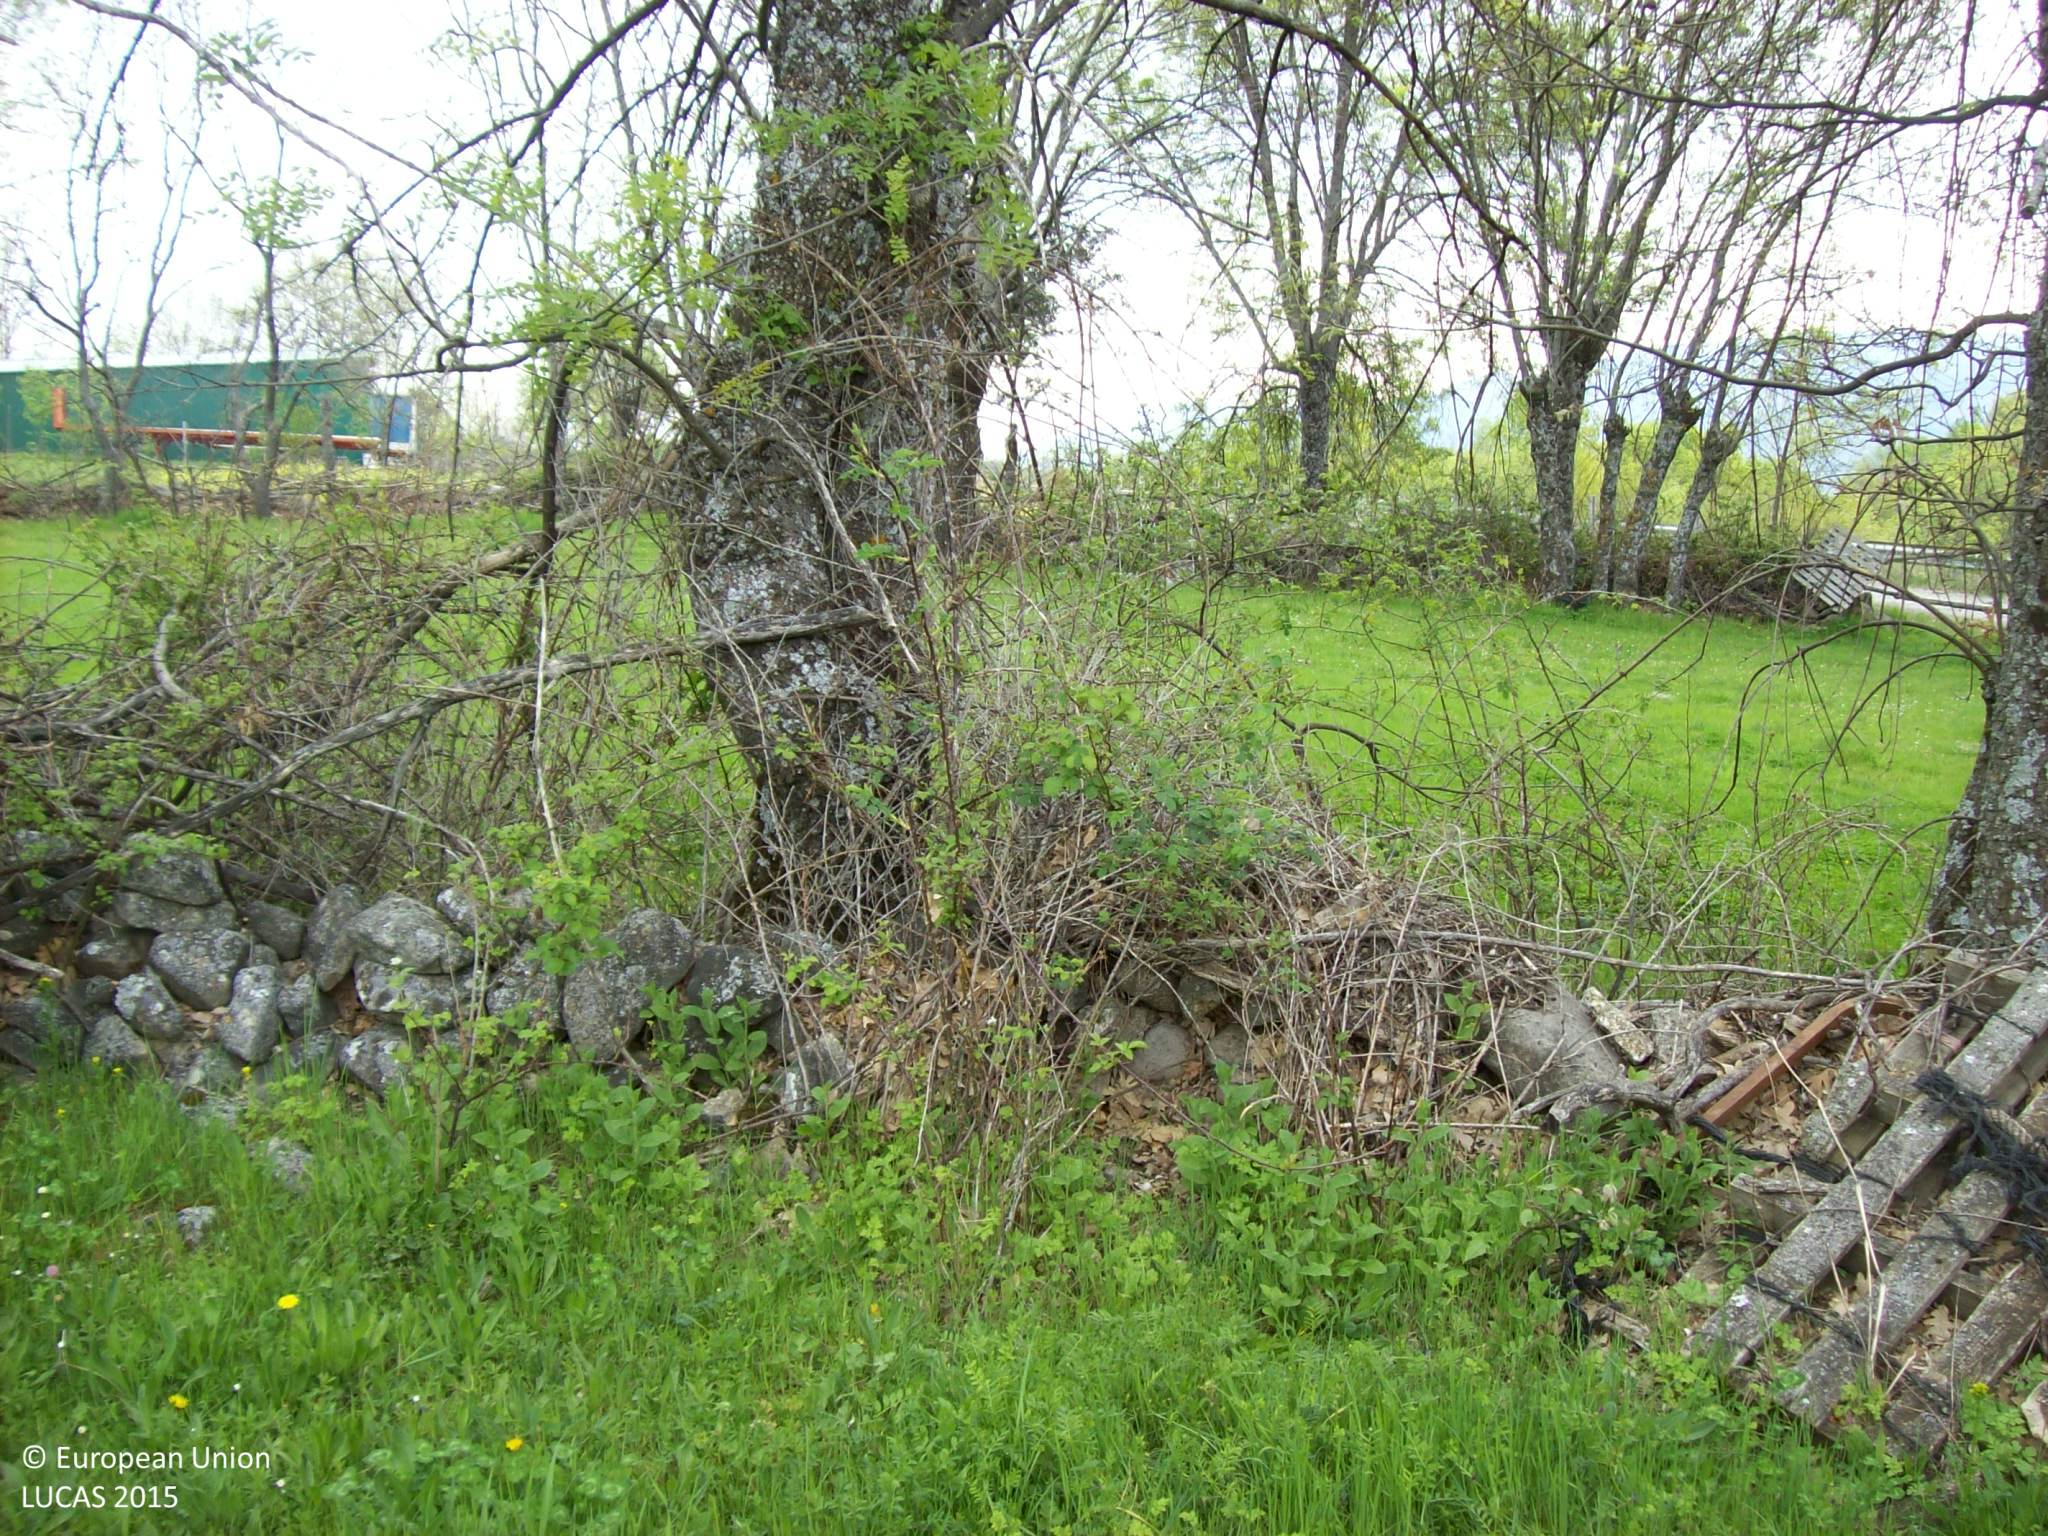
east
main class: Grassland
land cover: Grassland without tree/shrub cover
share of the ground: > 75 %
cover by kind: herbaceous plants 100 %
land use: Agriculture (excluding fallow land and kitchen gardens)
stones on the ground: < 10 %
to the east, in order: Grassland without tree/shrub cover; Shruby margins; Abandoned hedges; Dry stone walls; Grassland without tree/shrub cover; Abandoned hedges; Dry stone walls; Tracks; Dry stone walls; Abandoned hedges; Grassland with sparse tree/shrub cover; Artificial constructions in urban areas; Abandoned hedges; Dry stone walls; Tracks; Grassland with sparse tree/shrub cover; Vineyards; Dry stone walls; Abandoned hedges; Broadleaved woodland; Dry stone walls; Grassland without tree/shrub cover; Abandoned hedges; Dry stone walls
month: April
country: ES
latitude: 40.4584
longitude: -4.8070
